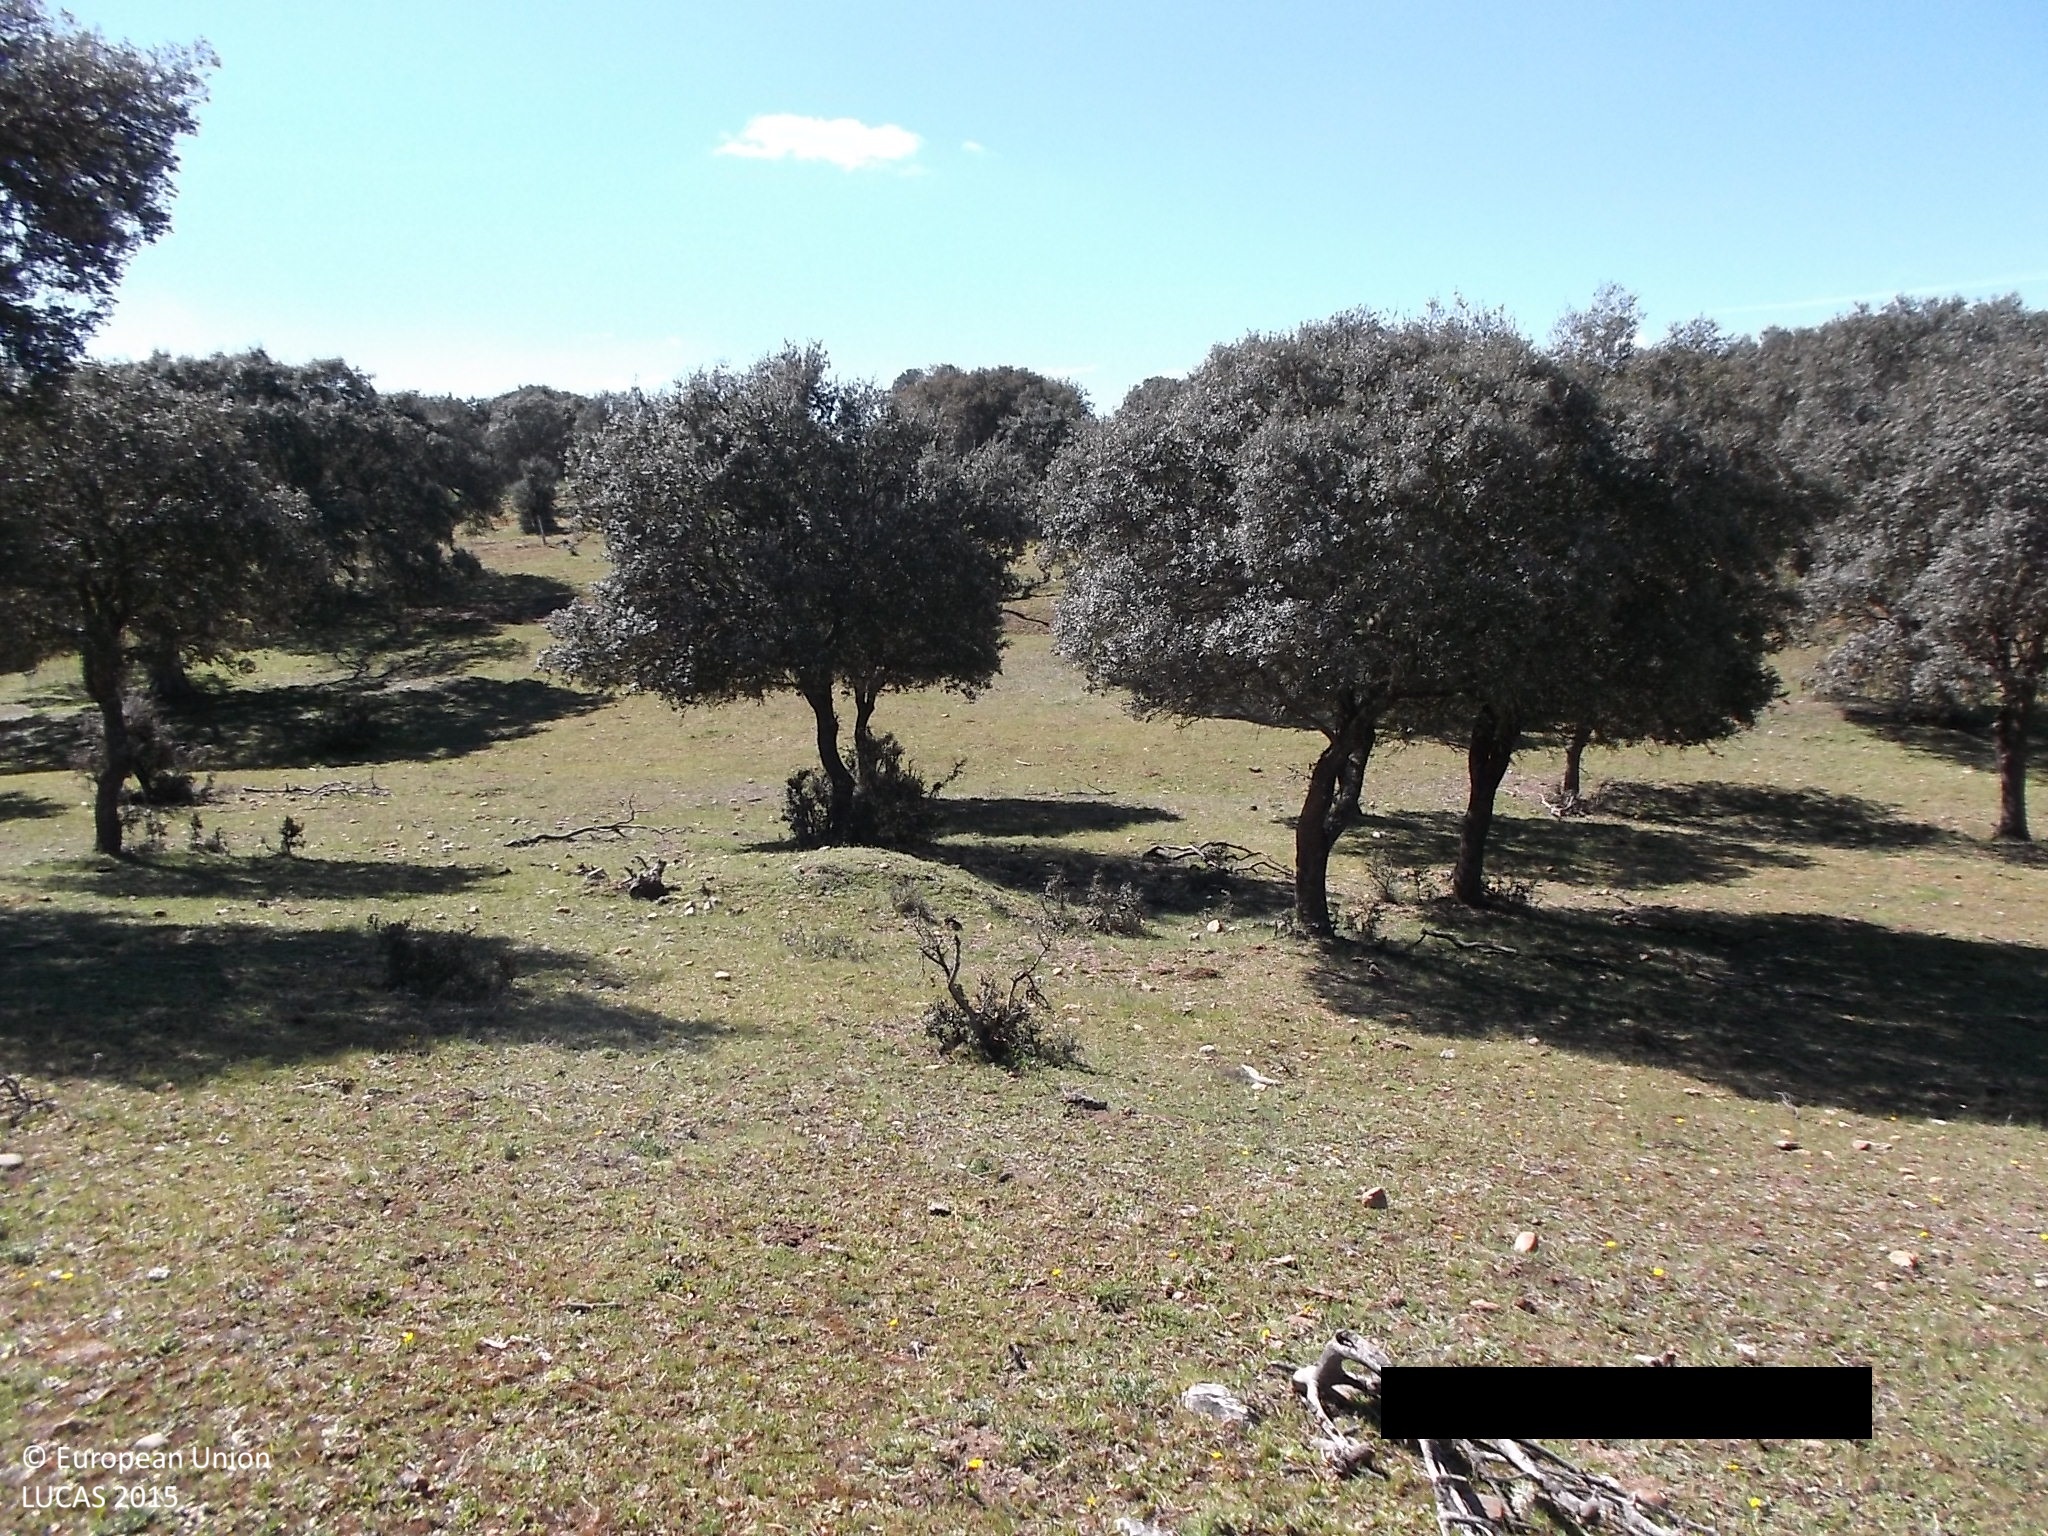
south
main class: Woodland
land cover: Broadleaved woodland
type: broadleaved evergreen forest
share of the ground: 25 - 50 %
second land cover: Grassland without tree/shrub cover
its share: 50 - 75 %
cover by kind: herbaceous plants 50 %, broadleaved forest trees 30 %, shrubs 20 %
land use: Forestry
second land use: Agriculture (excluding fallow land and kitchen gardens)
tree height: < 5 m
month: April
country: ES
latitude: 41.0722
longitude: -5.9249
